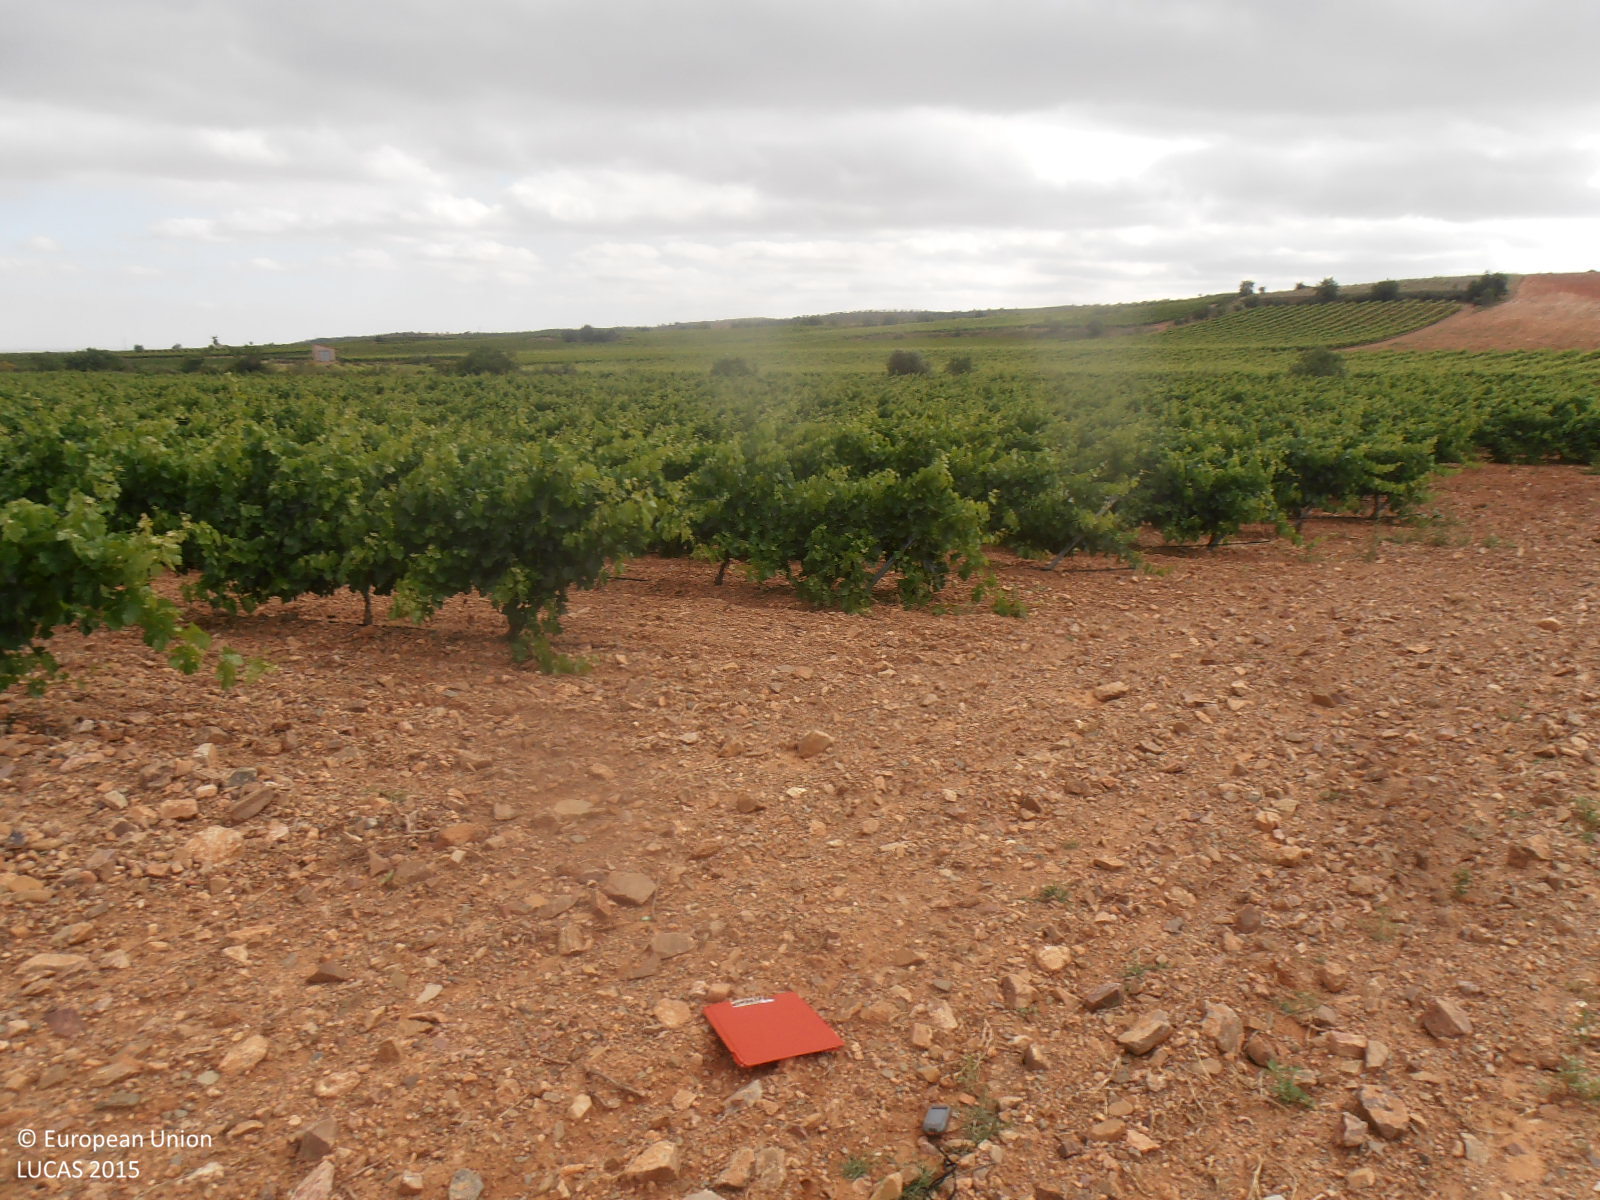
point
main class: Cropland
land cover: Vineyards
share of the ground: 25 - 50 %
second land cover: Other bare soil
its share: > 75 %
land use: Agriculture (excluding fallow land and kitchen gardens)
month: June
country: ES
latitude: 41.3033
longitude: -1.1880
